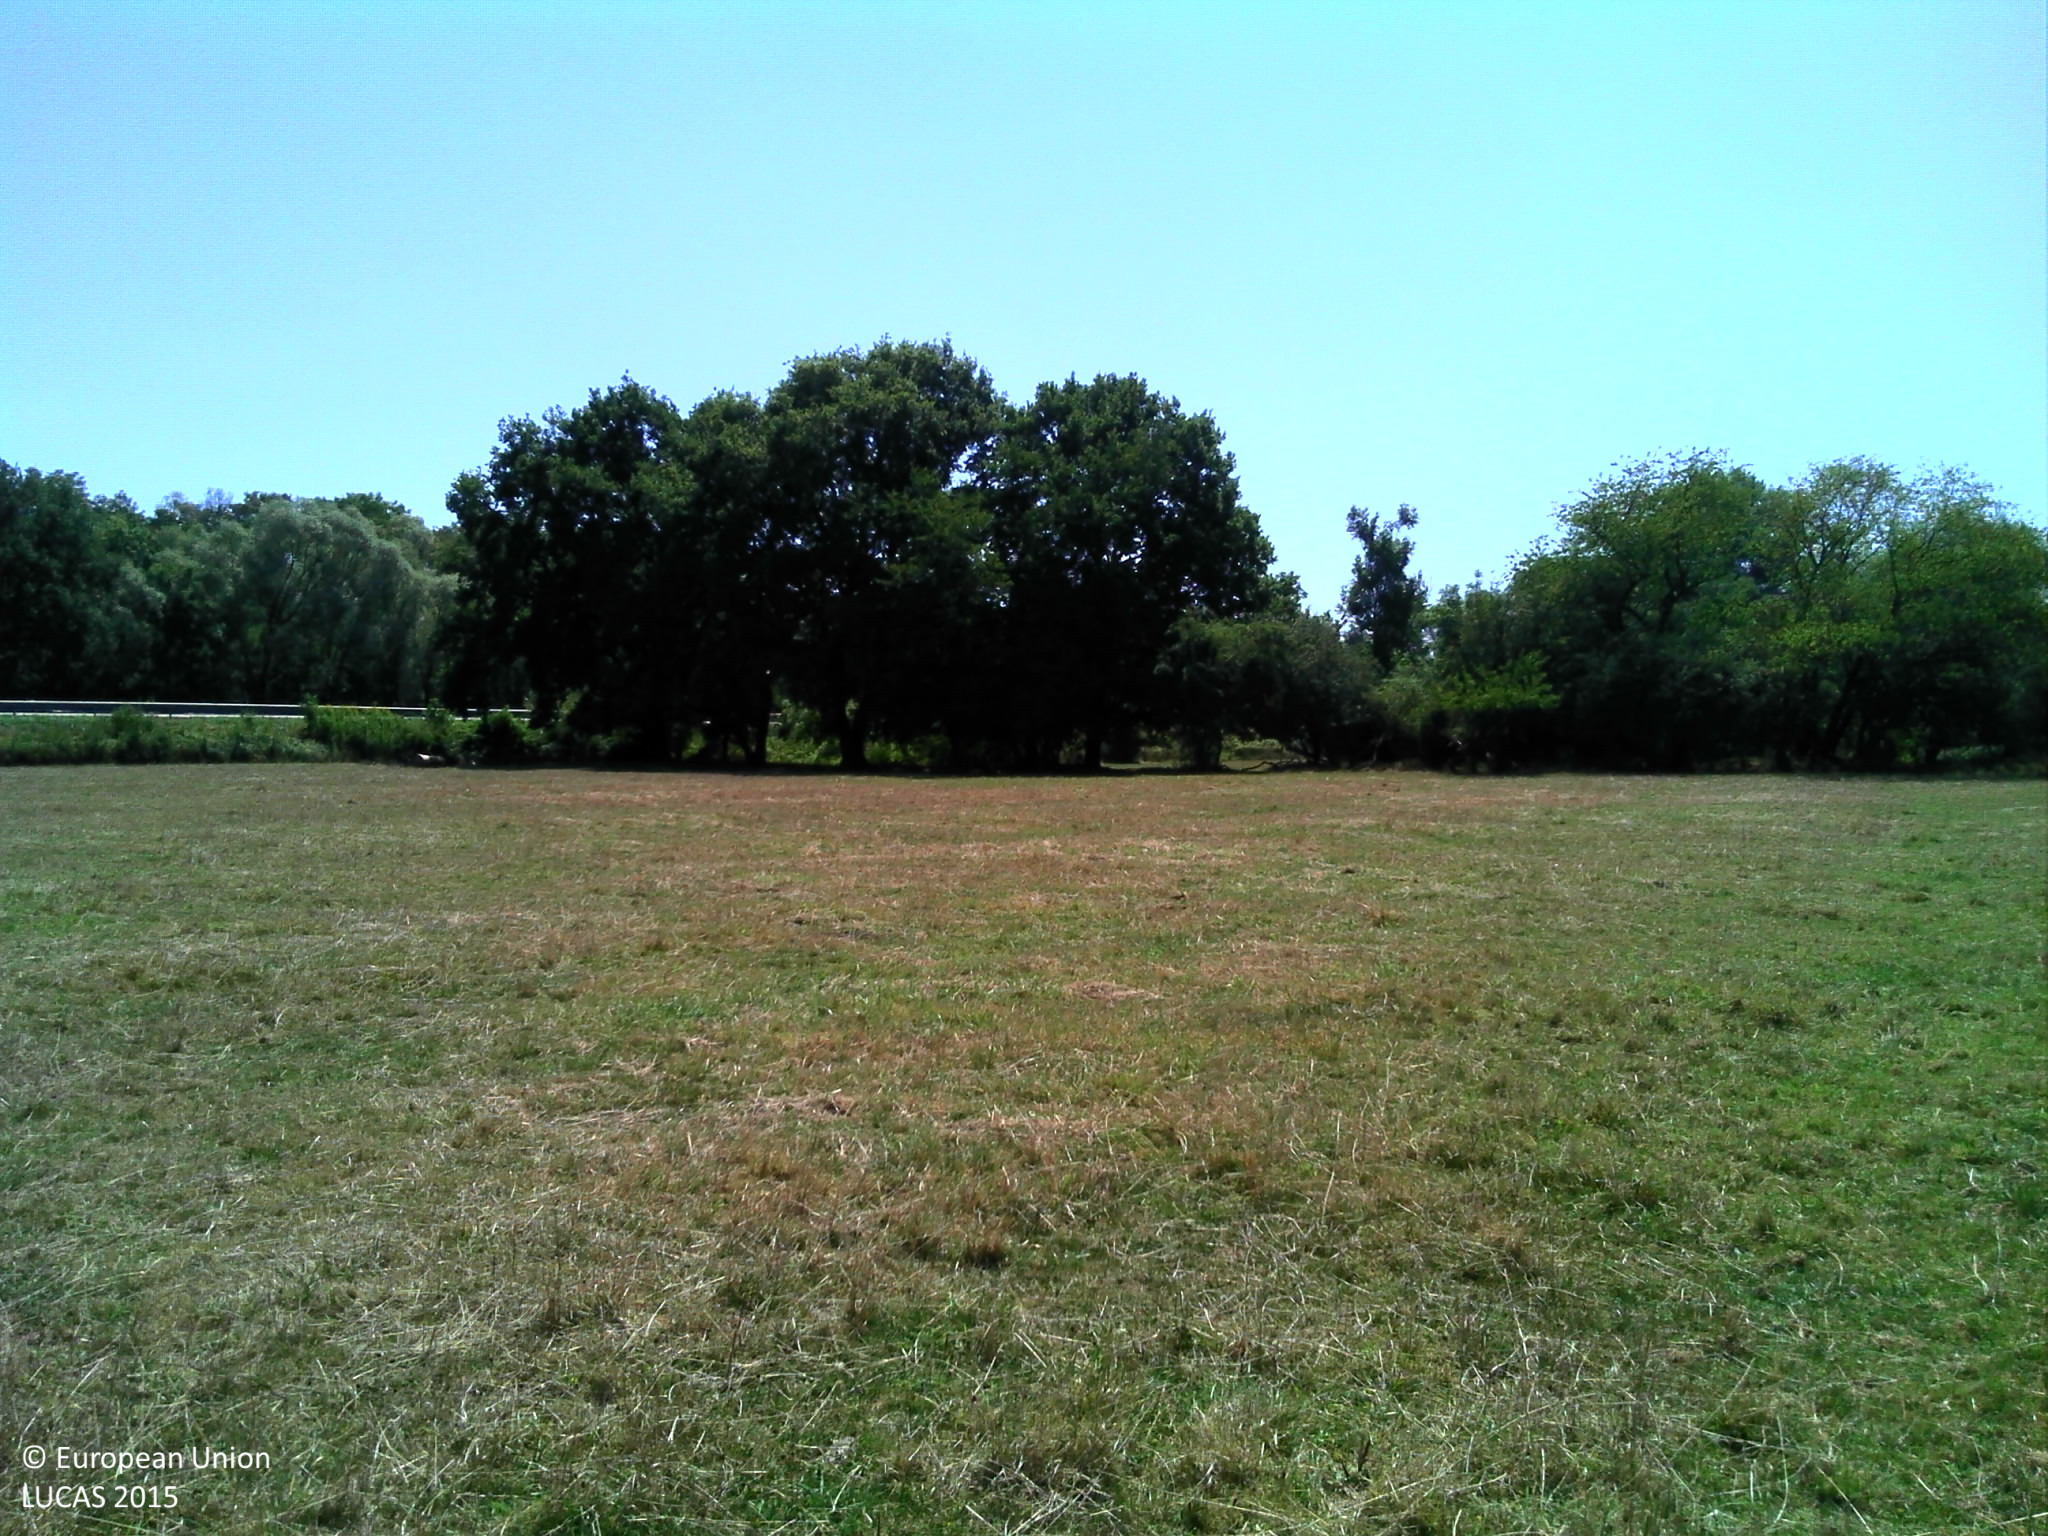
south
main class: Grassland
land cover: Grassland without tree/shrub cover
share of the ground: > 75 %
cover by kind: herbaceous plants 100 %
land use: Agriculture (excluding fallow land and kitchen gardens)
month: August
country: FR
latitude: 48.8543
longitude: 8.0517
